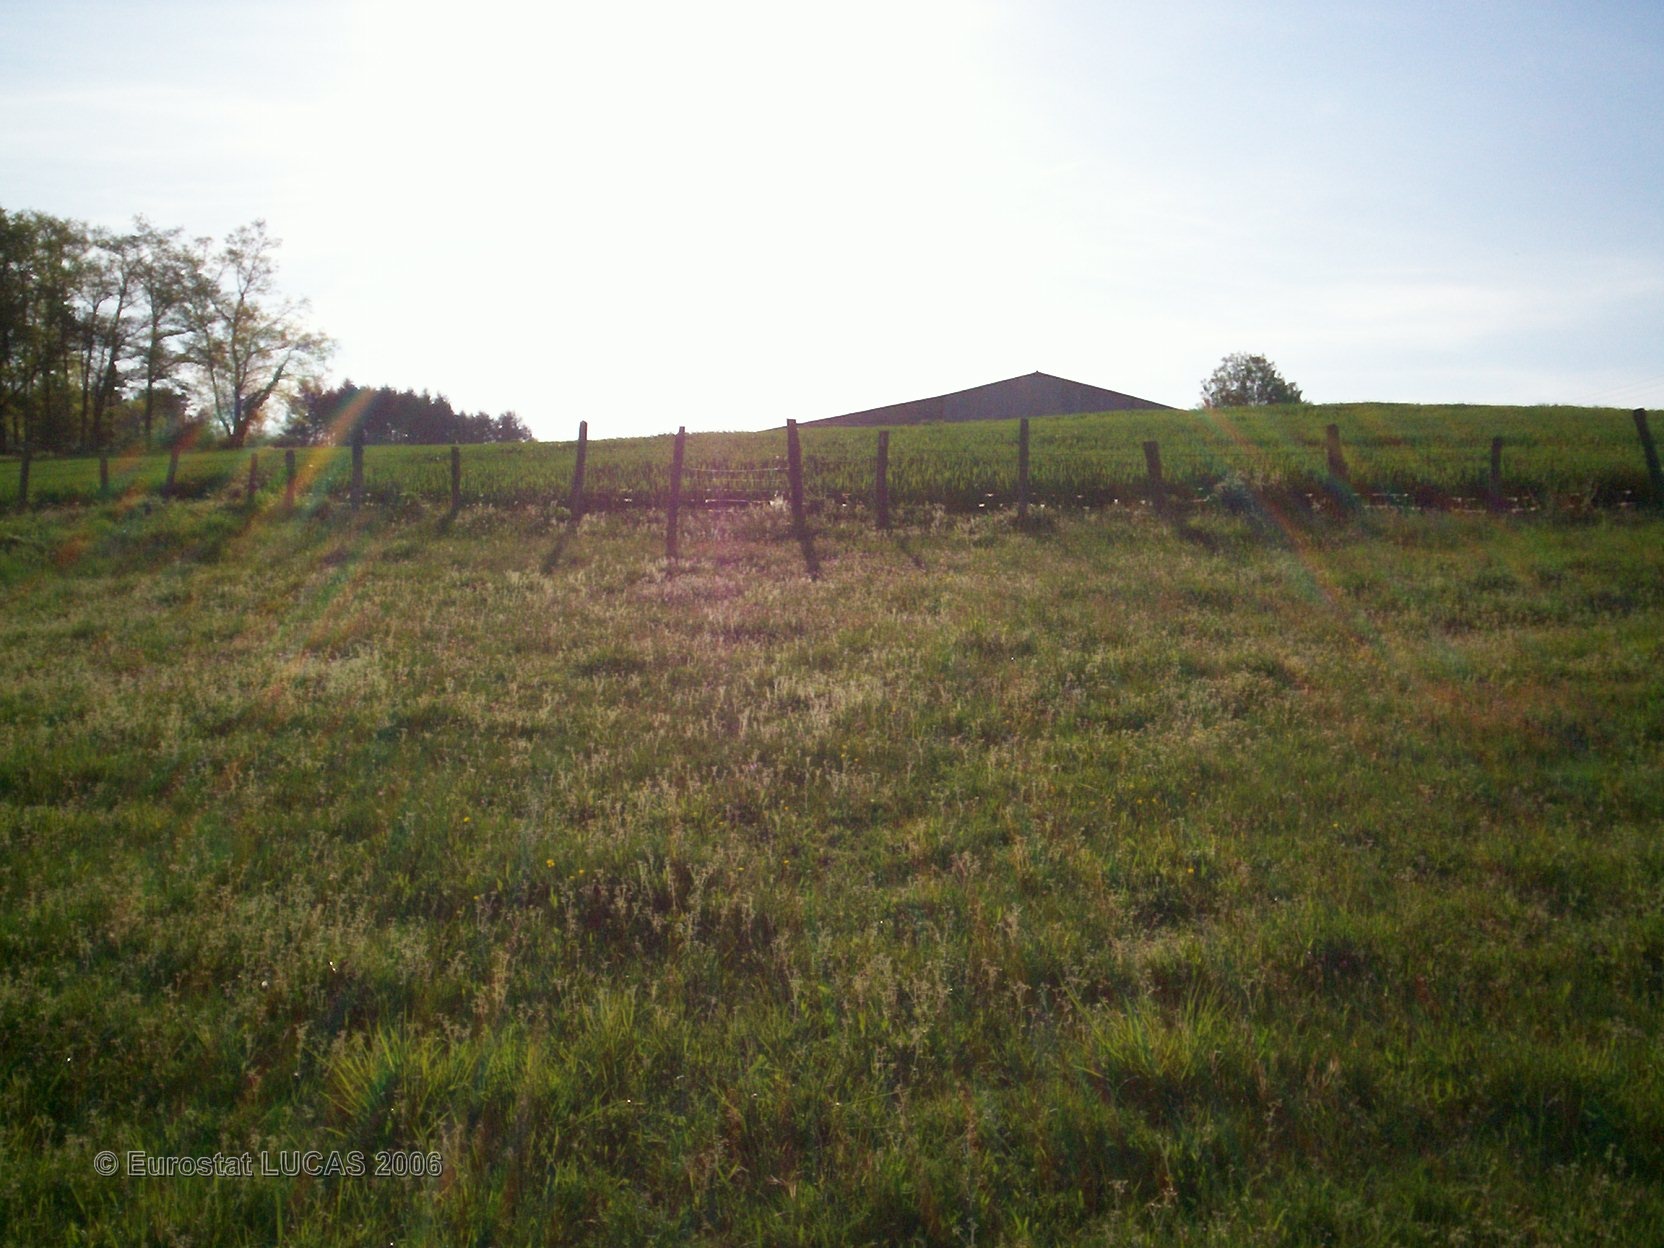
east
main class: Grassland
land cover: Grassland without tree/shrub cover
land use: Agriculture (excluding fallow land and kitchen gardens)
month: May
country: FR
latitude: 45.8905
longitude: 0.6951
